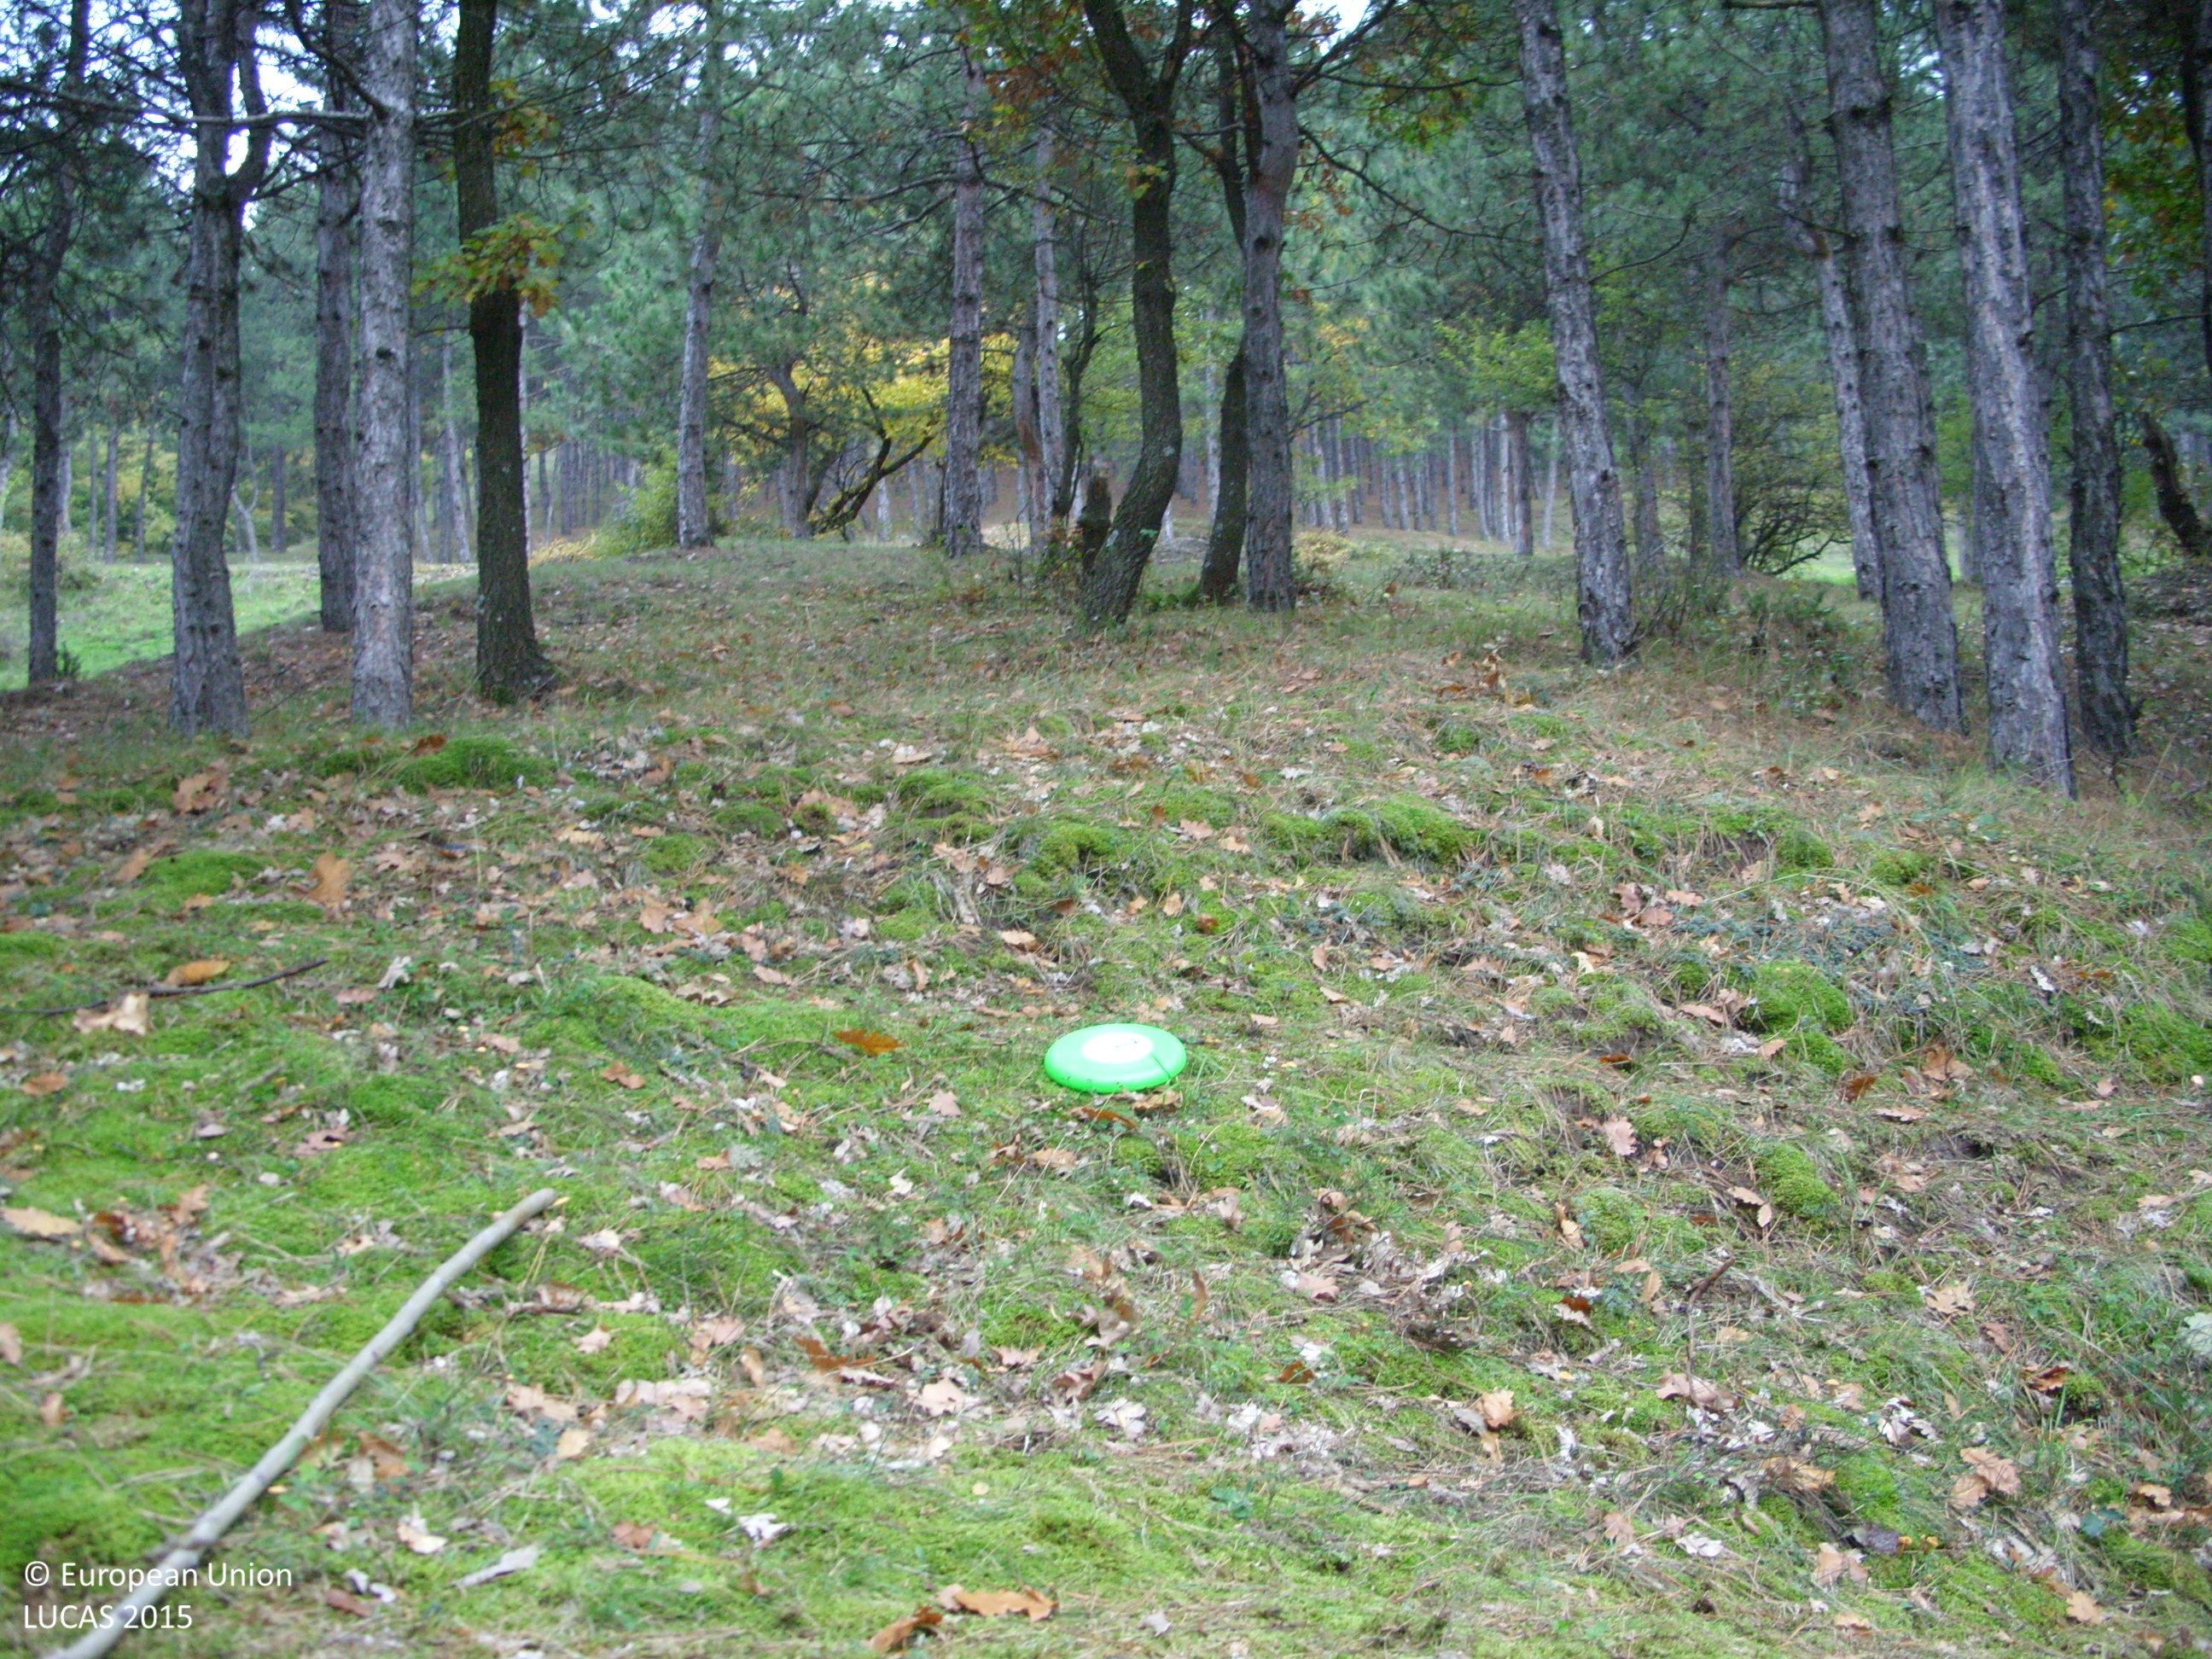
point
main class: Woodland
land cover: Pine dominated mixed woodland
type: hemiboreal forest and nemoral coniferous forest and mixed broadleaved-coniferous forest
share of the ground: > 75 %
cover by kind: coniferous forest trees 40 %, broadleaved forest trees 40 %, herbaceous plants 20 %
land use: Forestry
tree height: > 5 m
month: October
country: BG
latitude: 42.4939
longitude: 24.1717
